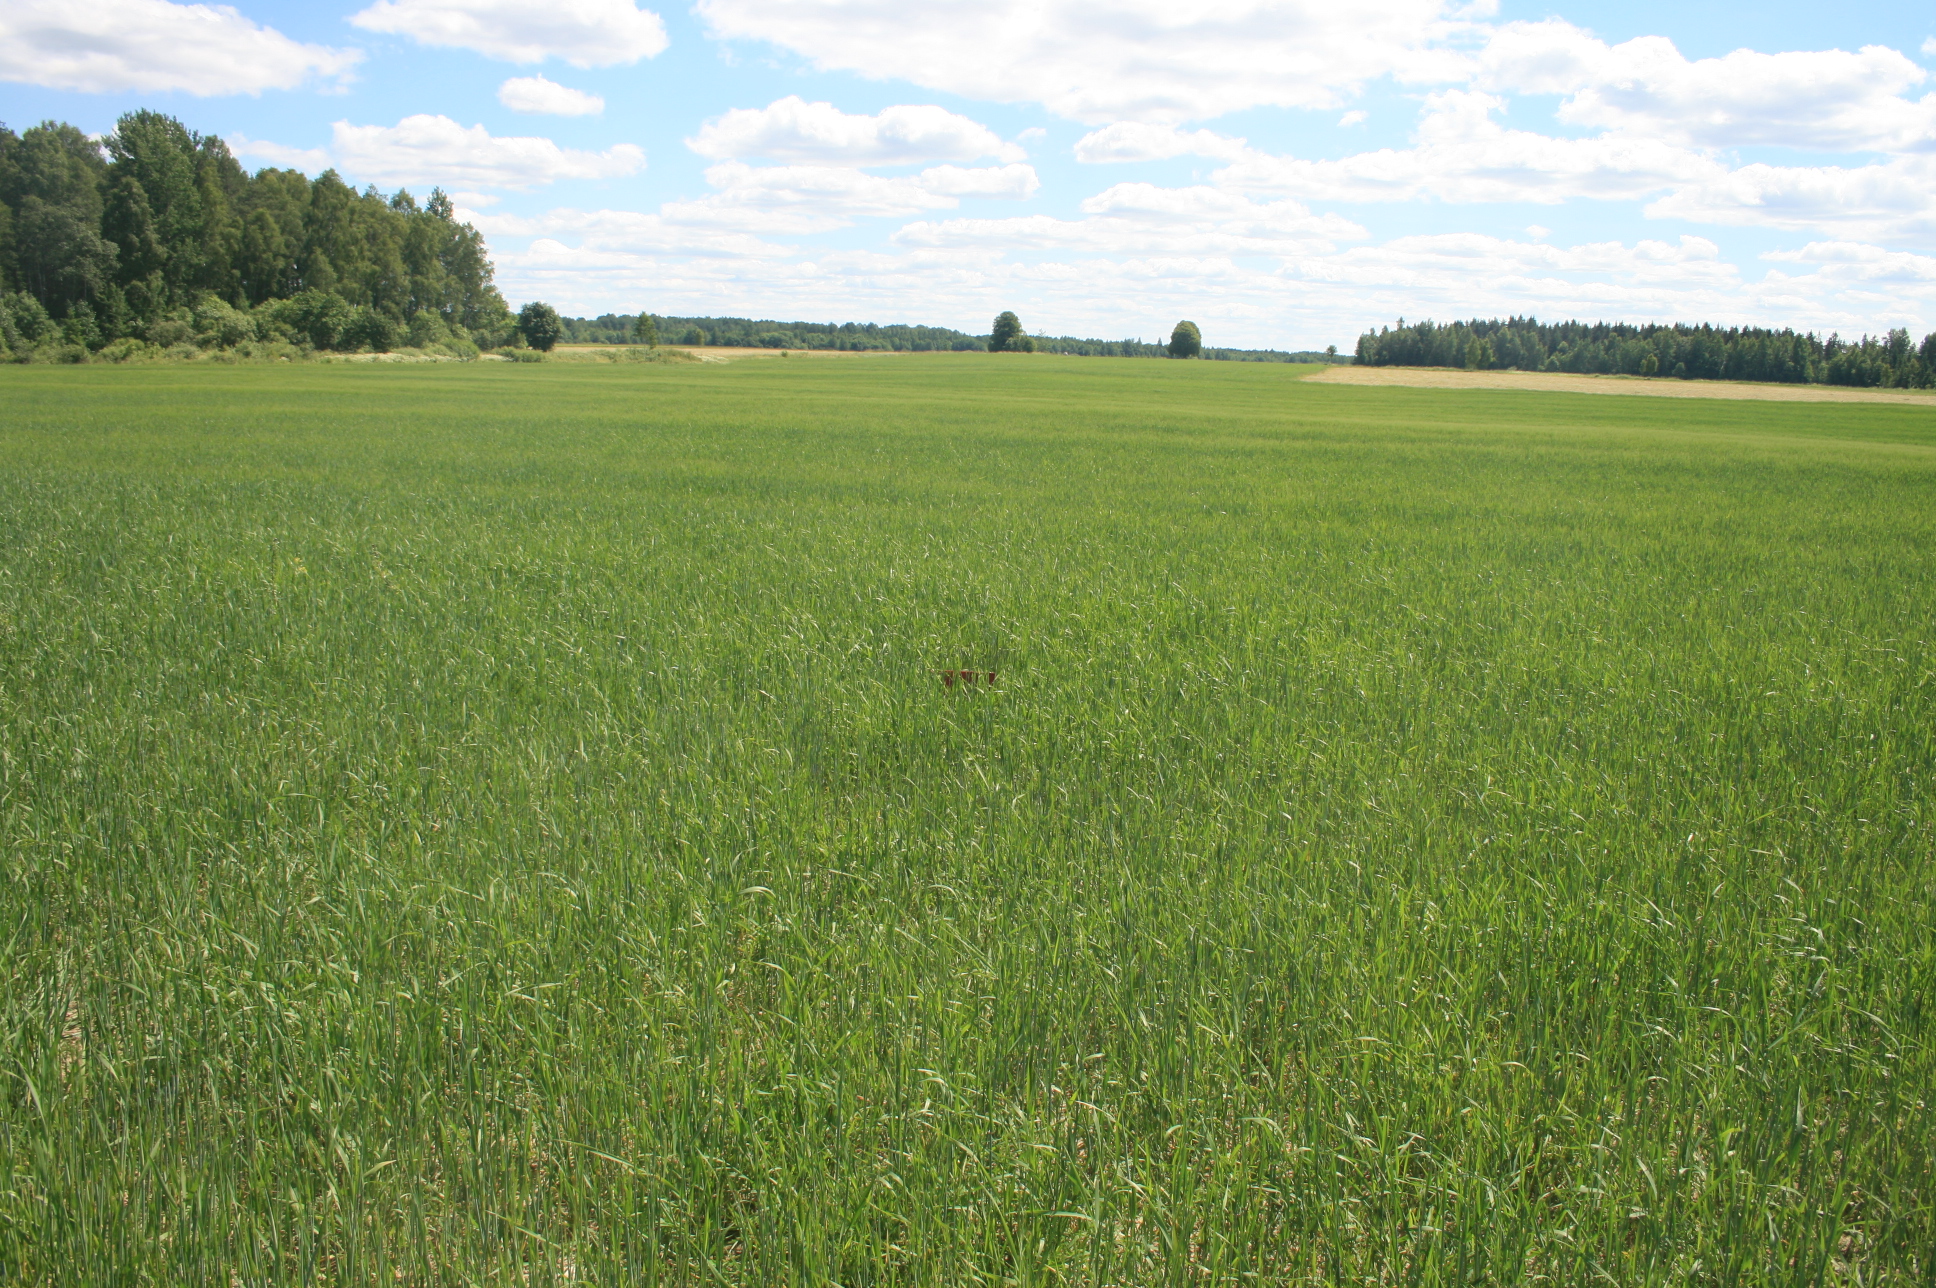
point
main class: Cropland
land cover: Barley
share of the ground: > 75 %
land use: Agriculture (excluding fallow land and kitchen gardens)
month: June
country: LT
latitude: 55.4294
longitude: 22.1123
